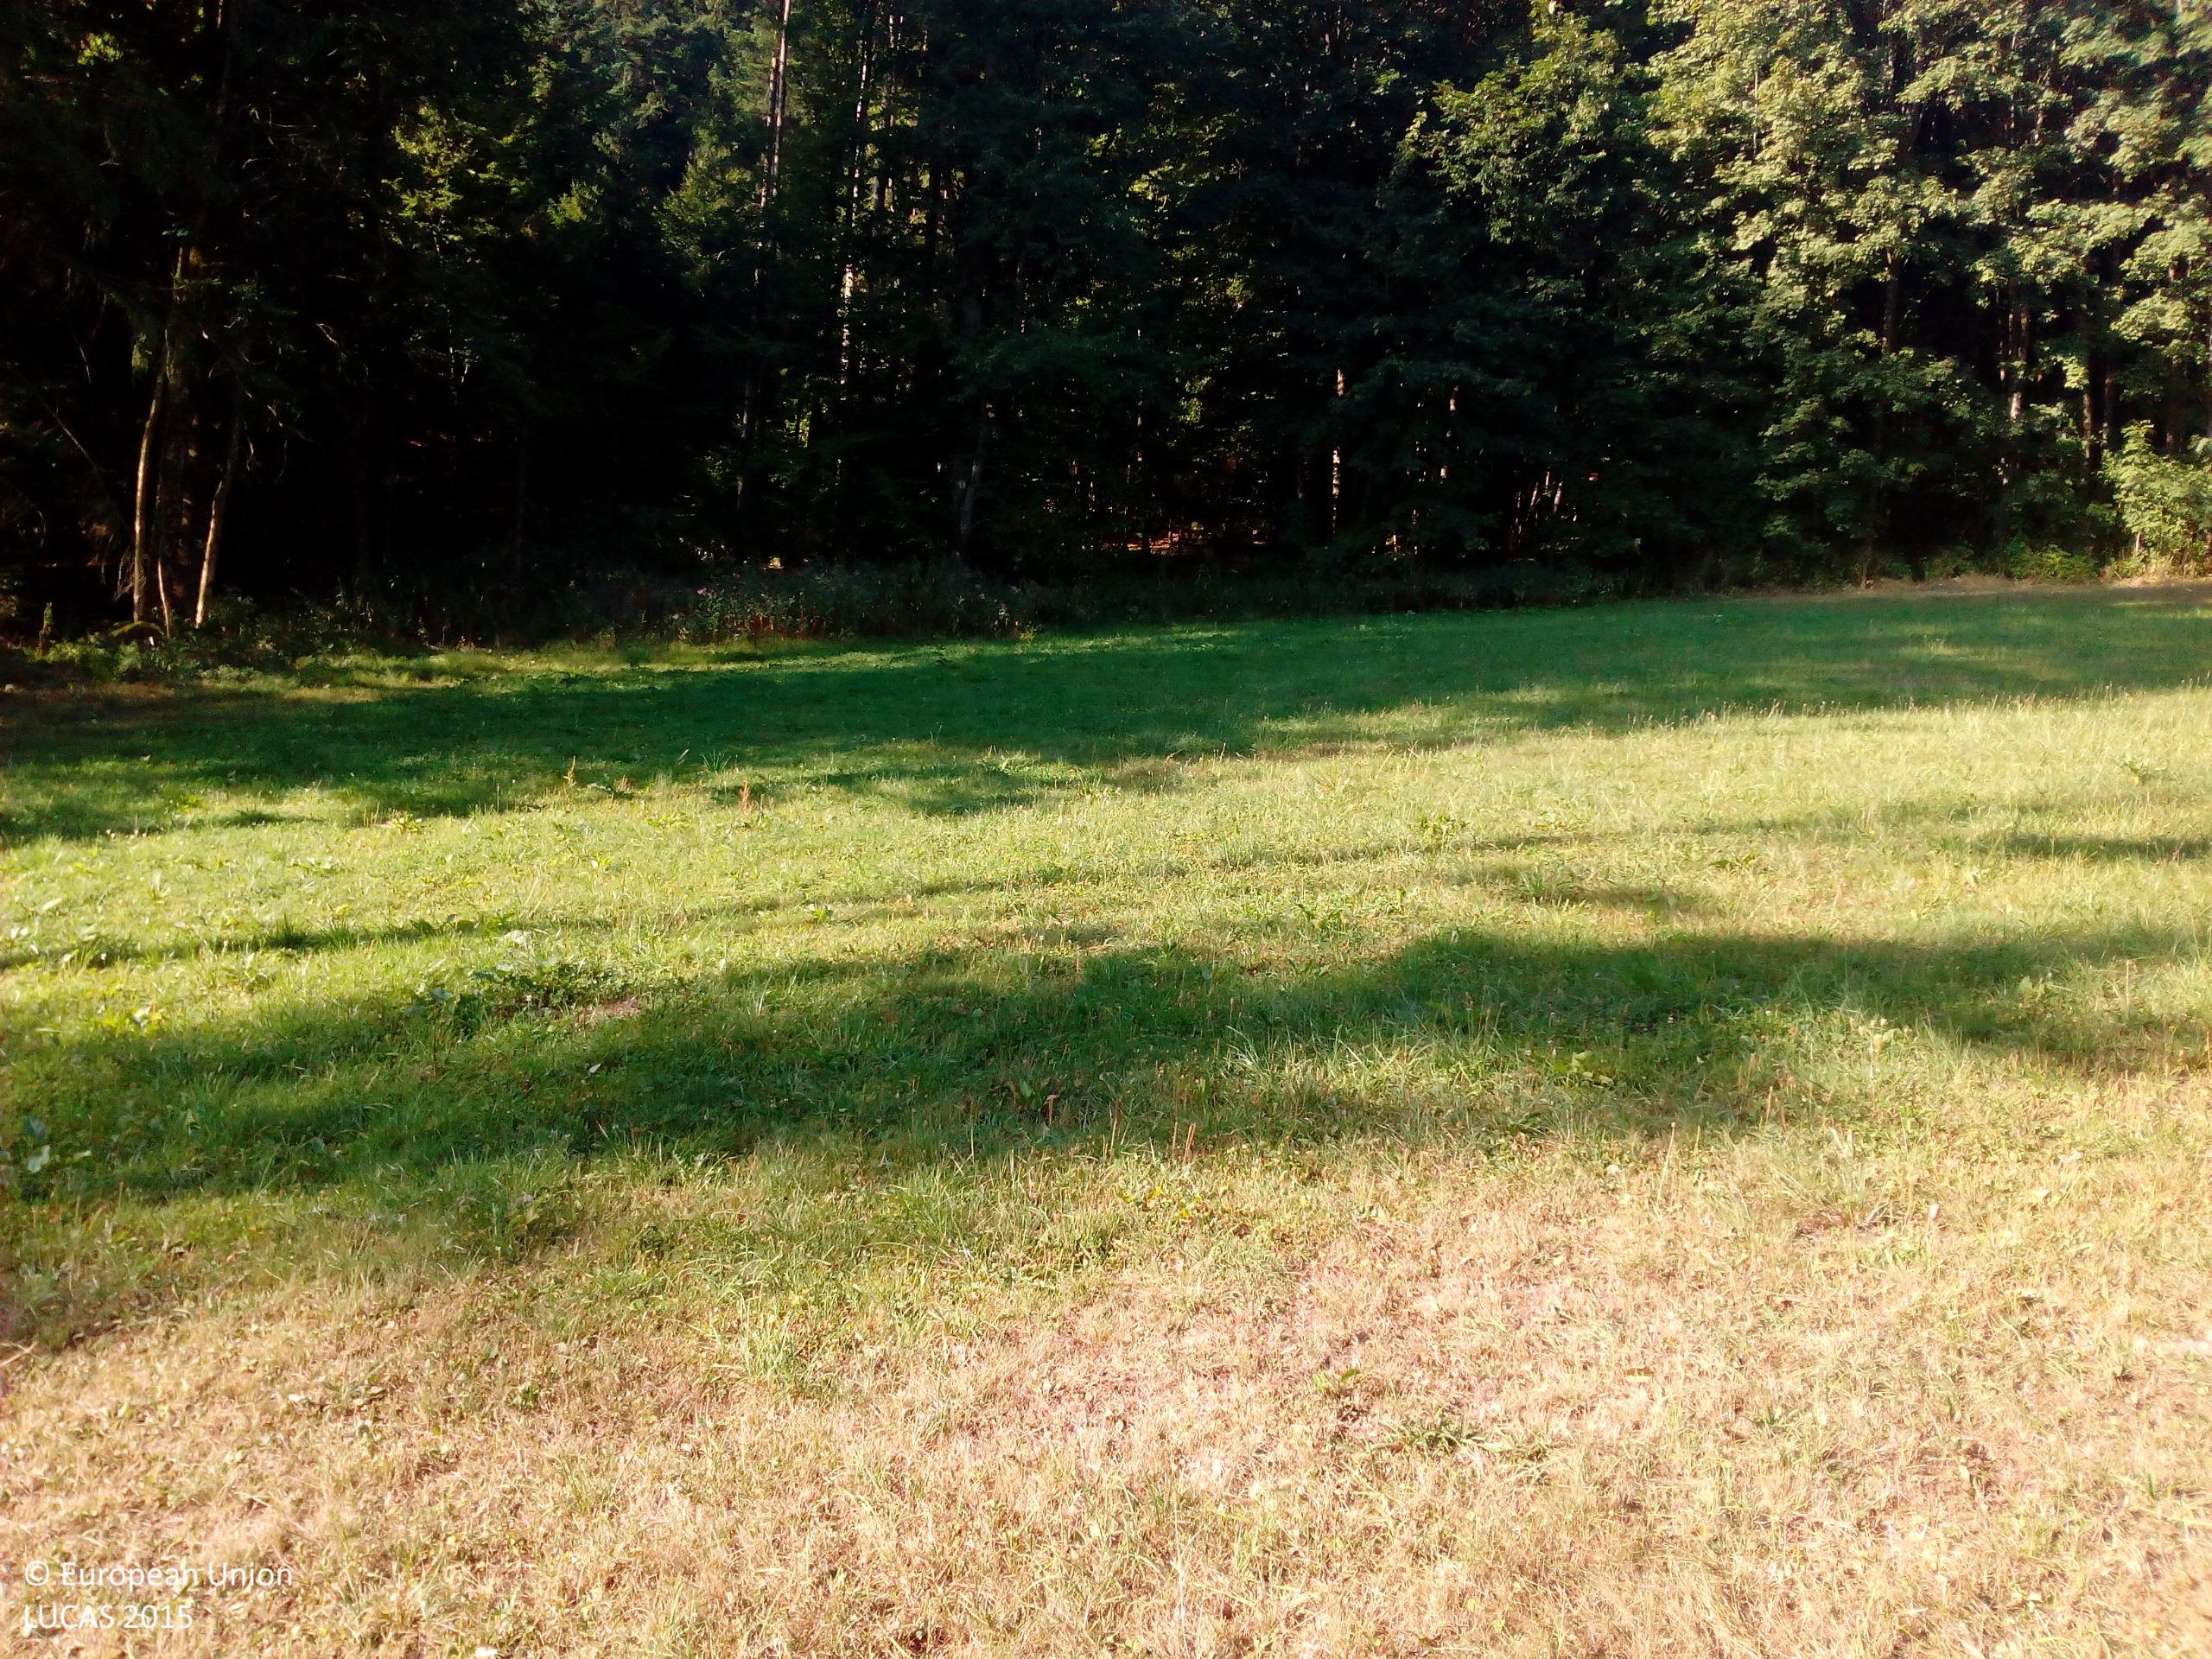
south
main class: Grassland
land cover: Grassland without tree/shrub cover
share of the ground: 50 - 75 %
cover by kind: herbaceous plants 70 %, unconsolidated bare surface 30 %
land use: Agriculture (excluding fallow land and kitchen gardens)
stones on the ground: < 10 %
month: September
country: DE
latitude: 48.8573
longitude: 13.3390
